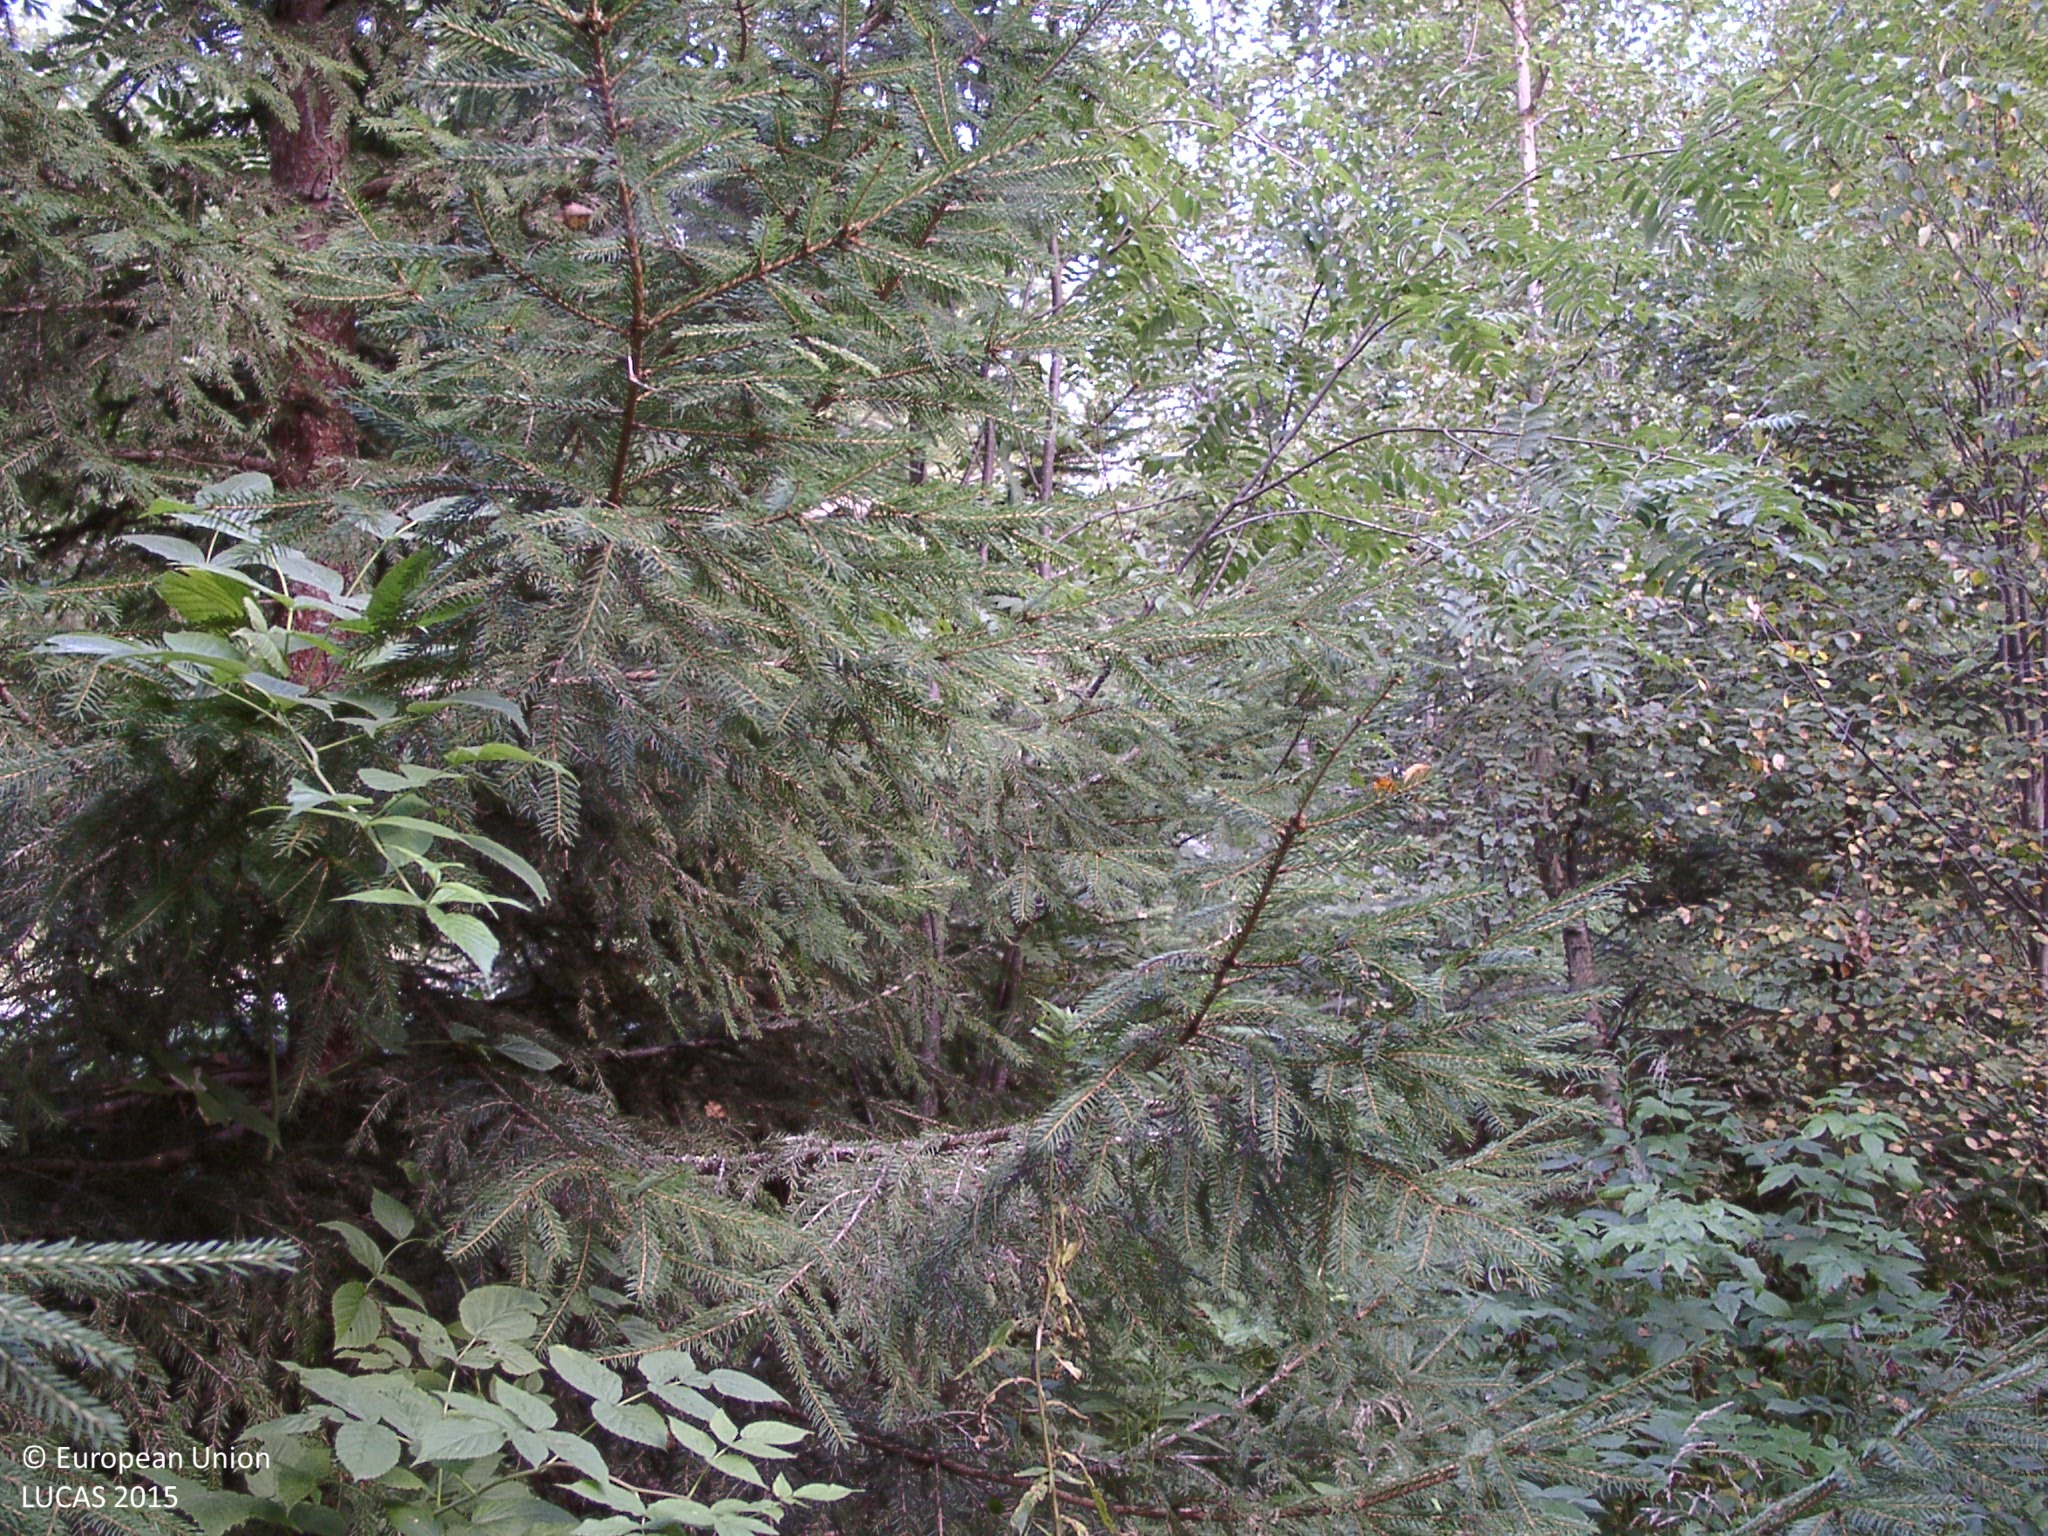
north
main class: Woodland
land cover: Broadleaved woodland
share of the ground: 50 - 75 %
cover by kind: broadleaved forest trees 55 %, herbaceous plants 20 %, shrubs 15 %, coniferous forest trees 10 %
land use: Forestry
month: August
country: FI
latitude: 61.8057
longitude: 25.1171
